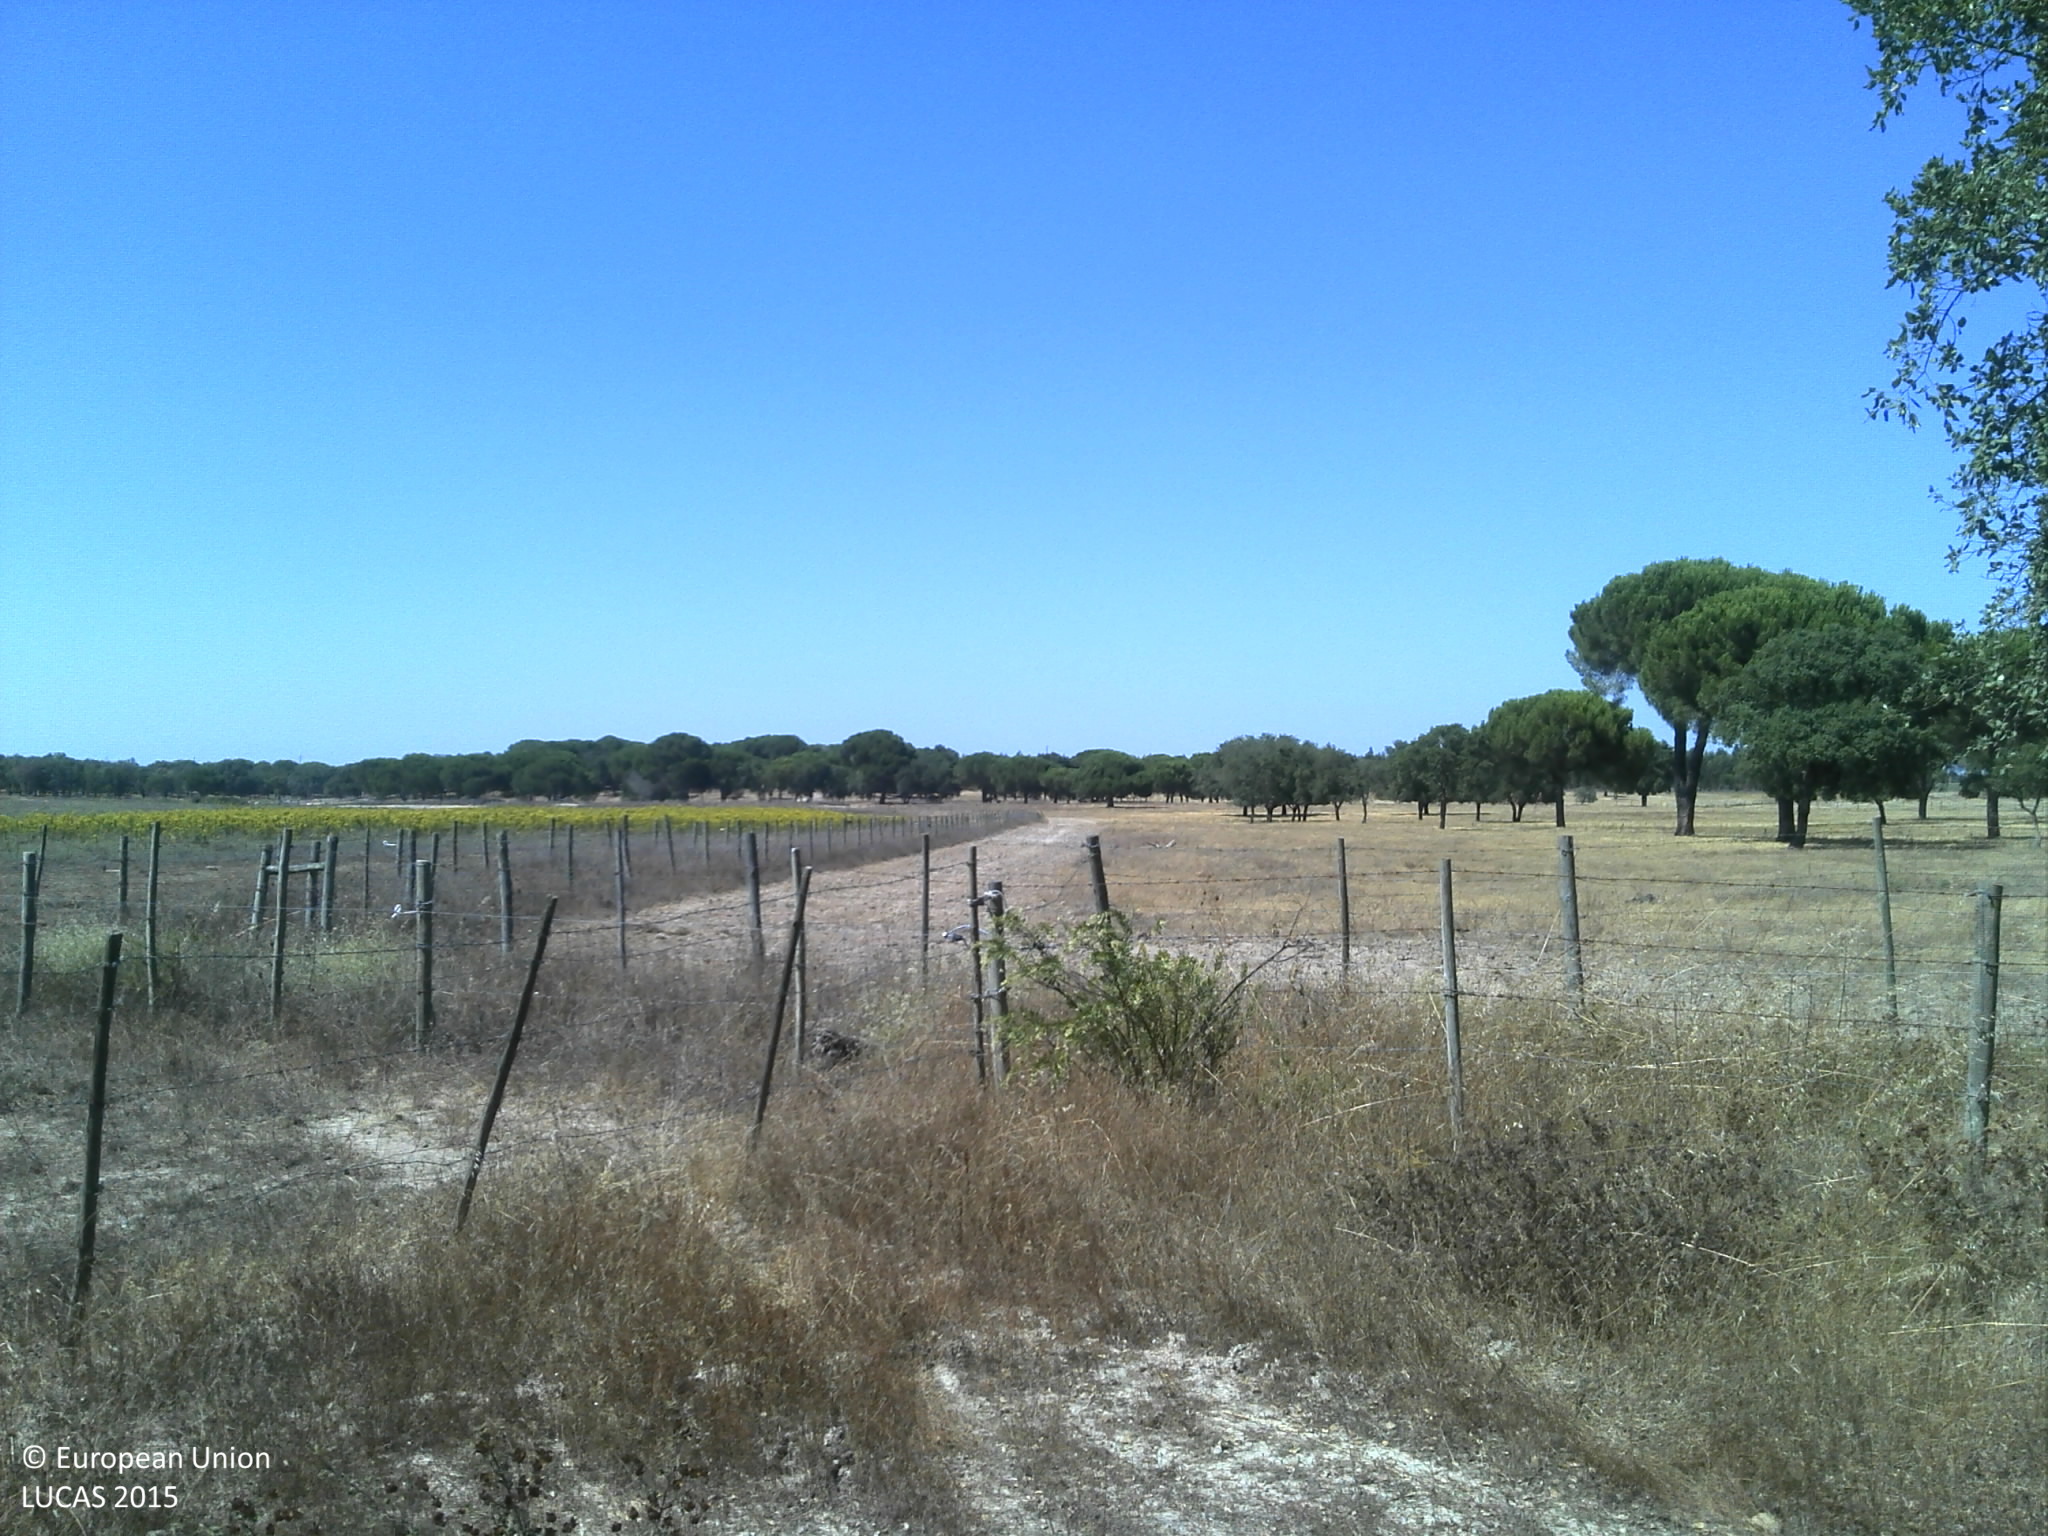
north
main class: Cropland
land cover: Temporary grasslands
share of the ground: 25 - 50 %
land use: Agriculture (excluding fallow land and kitchen gardens)
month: July
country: PT
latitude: 38.8368
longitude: -8.6222
